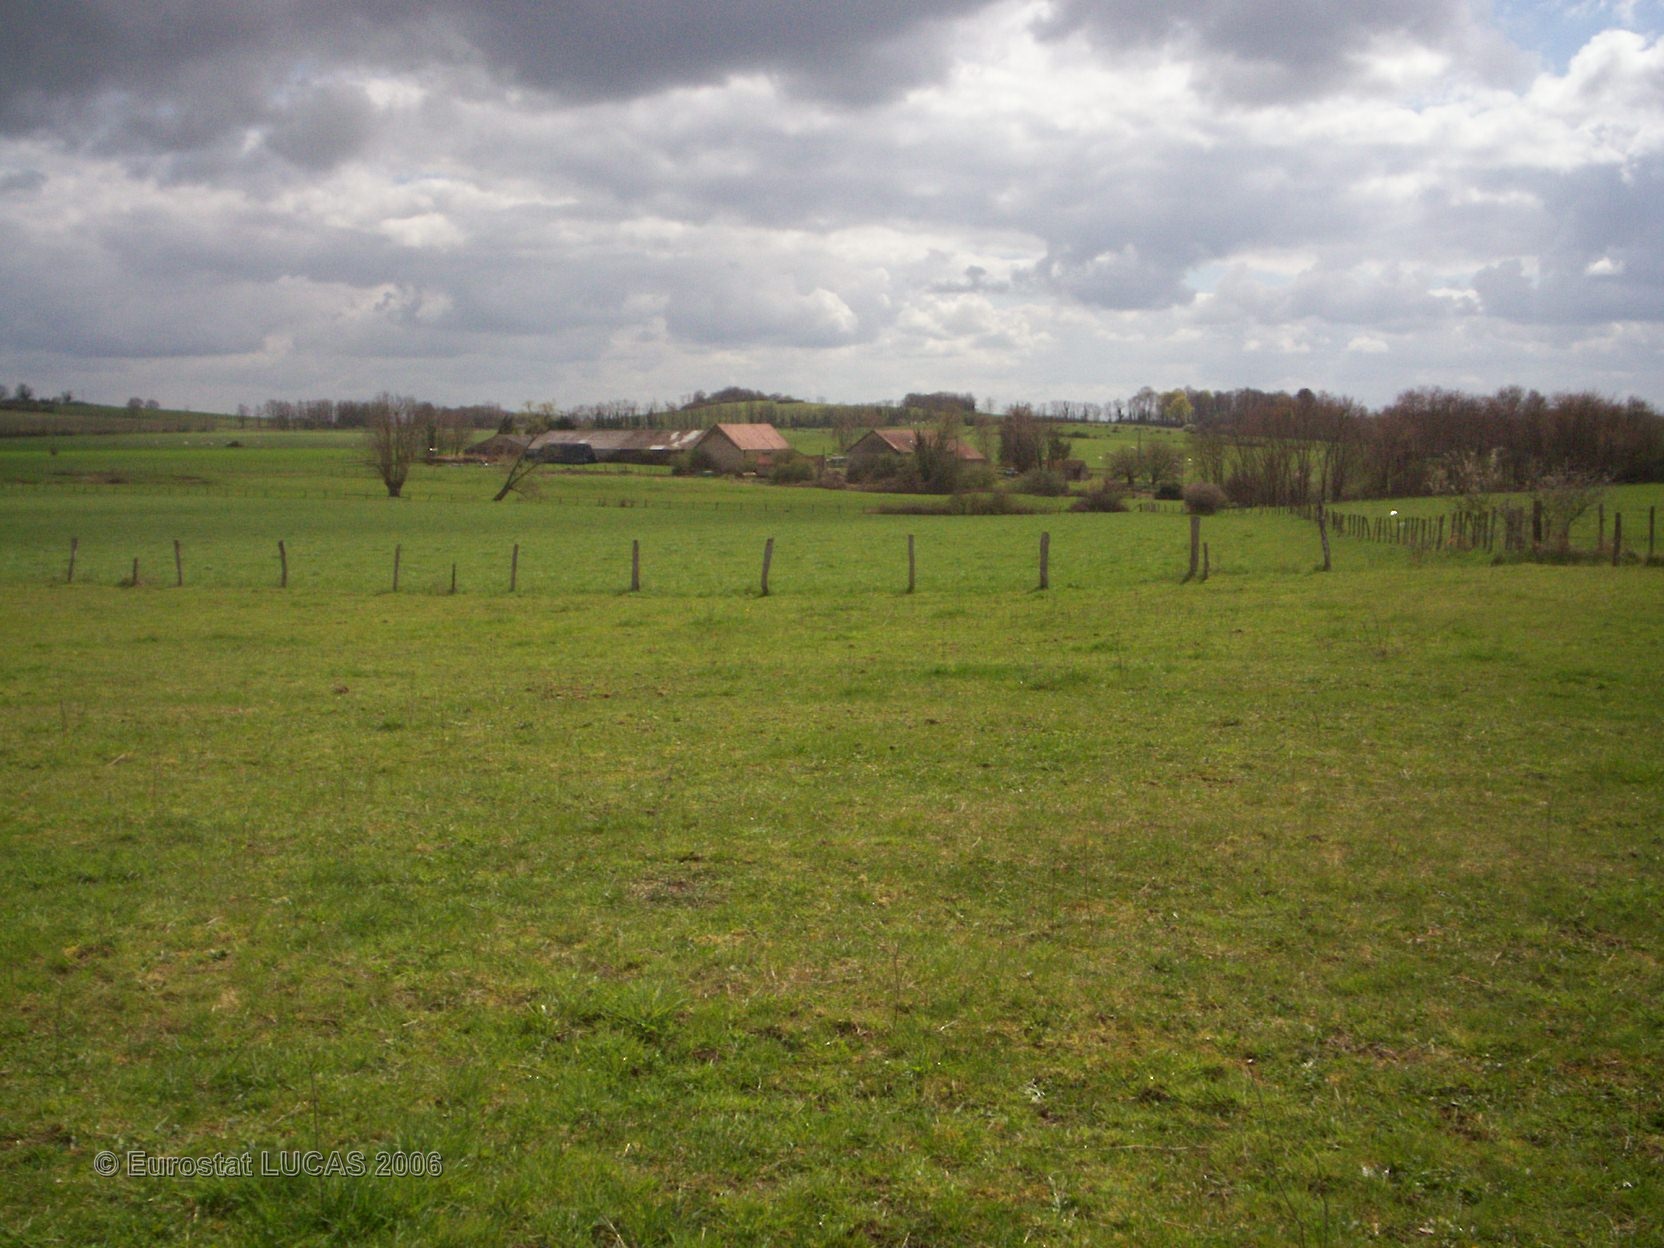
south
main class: Grassland
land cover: Grassland without tree/shrub cover
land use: Agriculture (excluding fallow land and kitchen gardens)
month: April
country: FR
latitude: 46.9219
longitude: 3.0756
